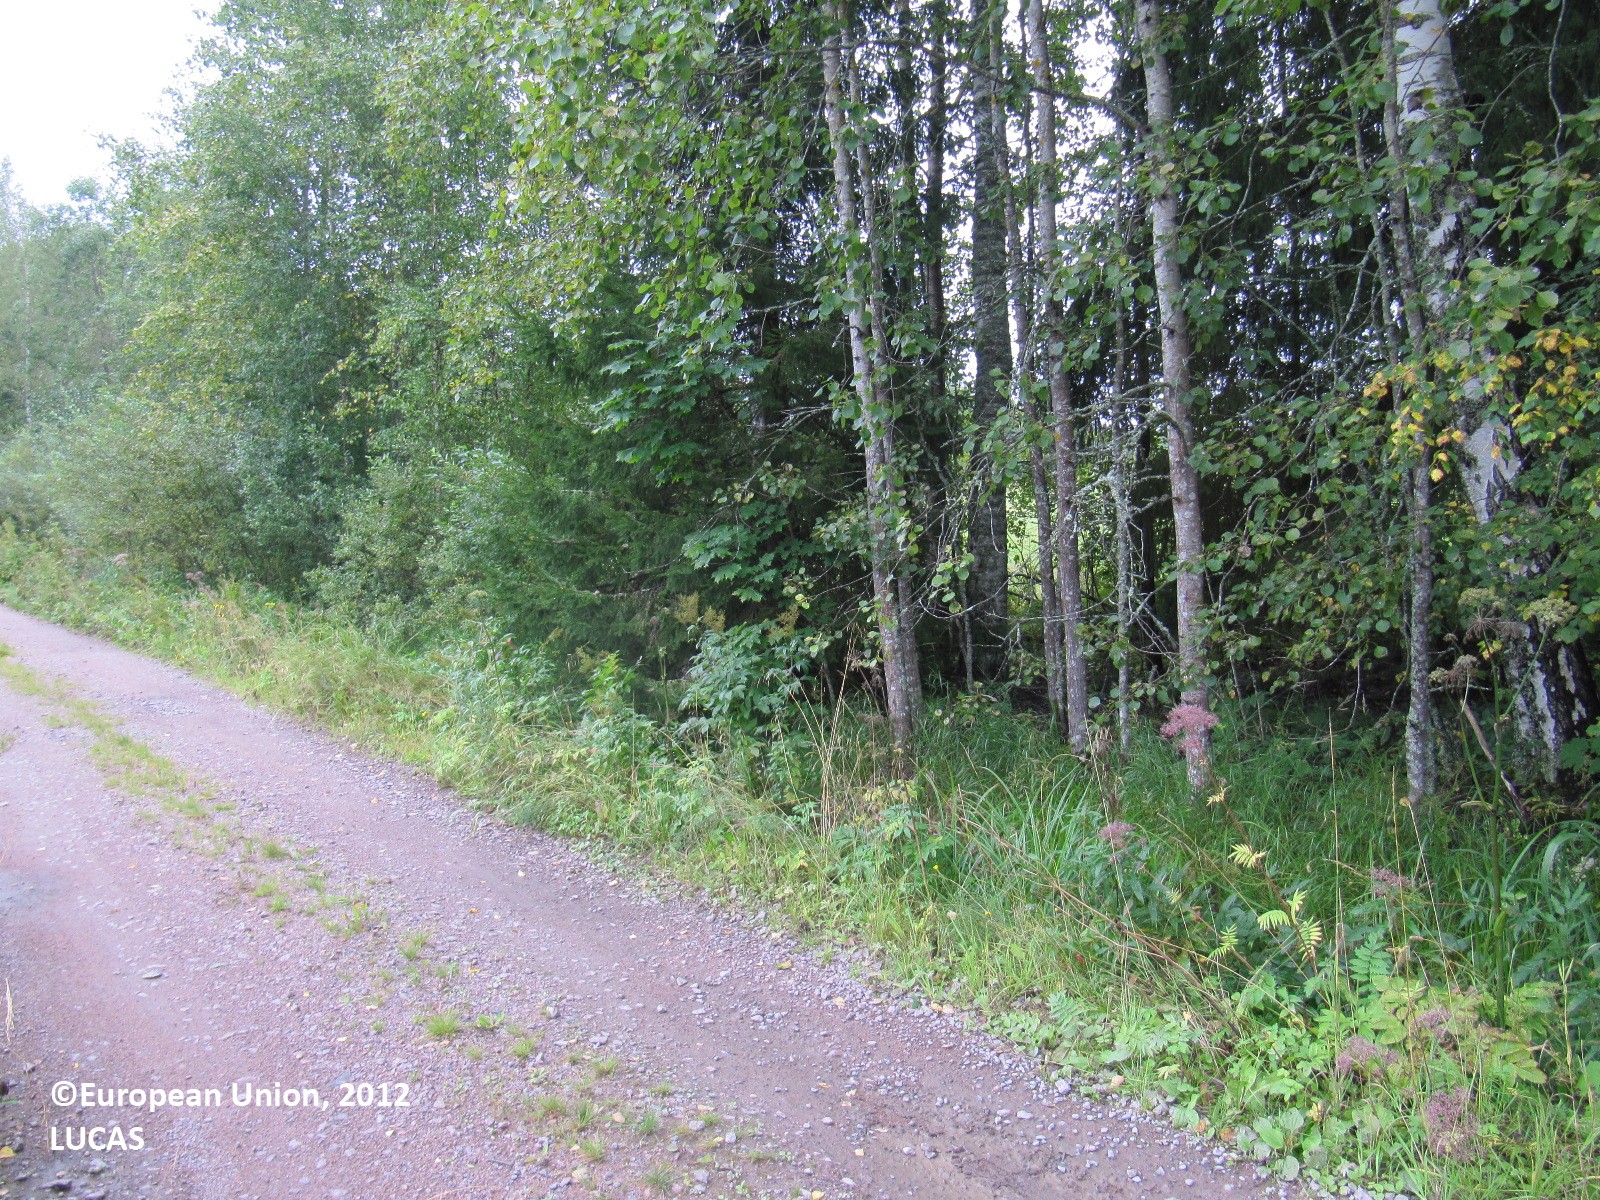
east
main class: Grassland
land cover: Grassland without tree/shrub cover
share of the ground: > 75 %
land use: Agriculture (excluding fallow land and kitchen gardens)
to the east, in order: Ditches and canals; Electric lines; Shruby margins; Paved roads, cycling and walking lanes; Grass margins; Ditches and canals; Broadleaved woodland; Grassland without tree/shrub cover; Electric lines; Spontaneously vegetated surfaces; Ditches and canals; Electric lines; Spontaneously vegetated surfaces; Paved roads, cycling and walking lanes; Grass margins; Ditches and canals; Spruce dominated mixed woodland; Artificial constructions in urban areas; Spruce dominated mixed woodland; Grassland without tree/shrub cover; Spruce dominated mixed woodland
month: August
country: FI
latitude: 60.2234
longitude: 24.2375
